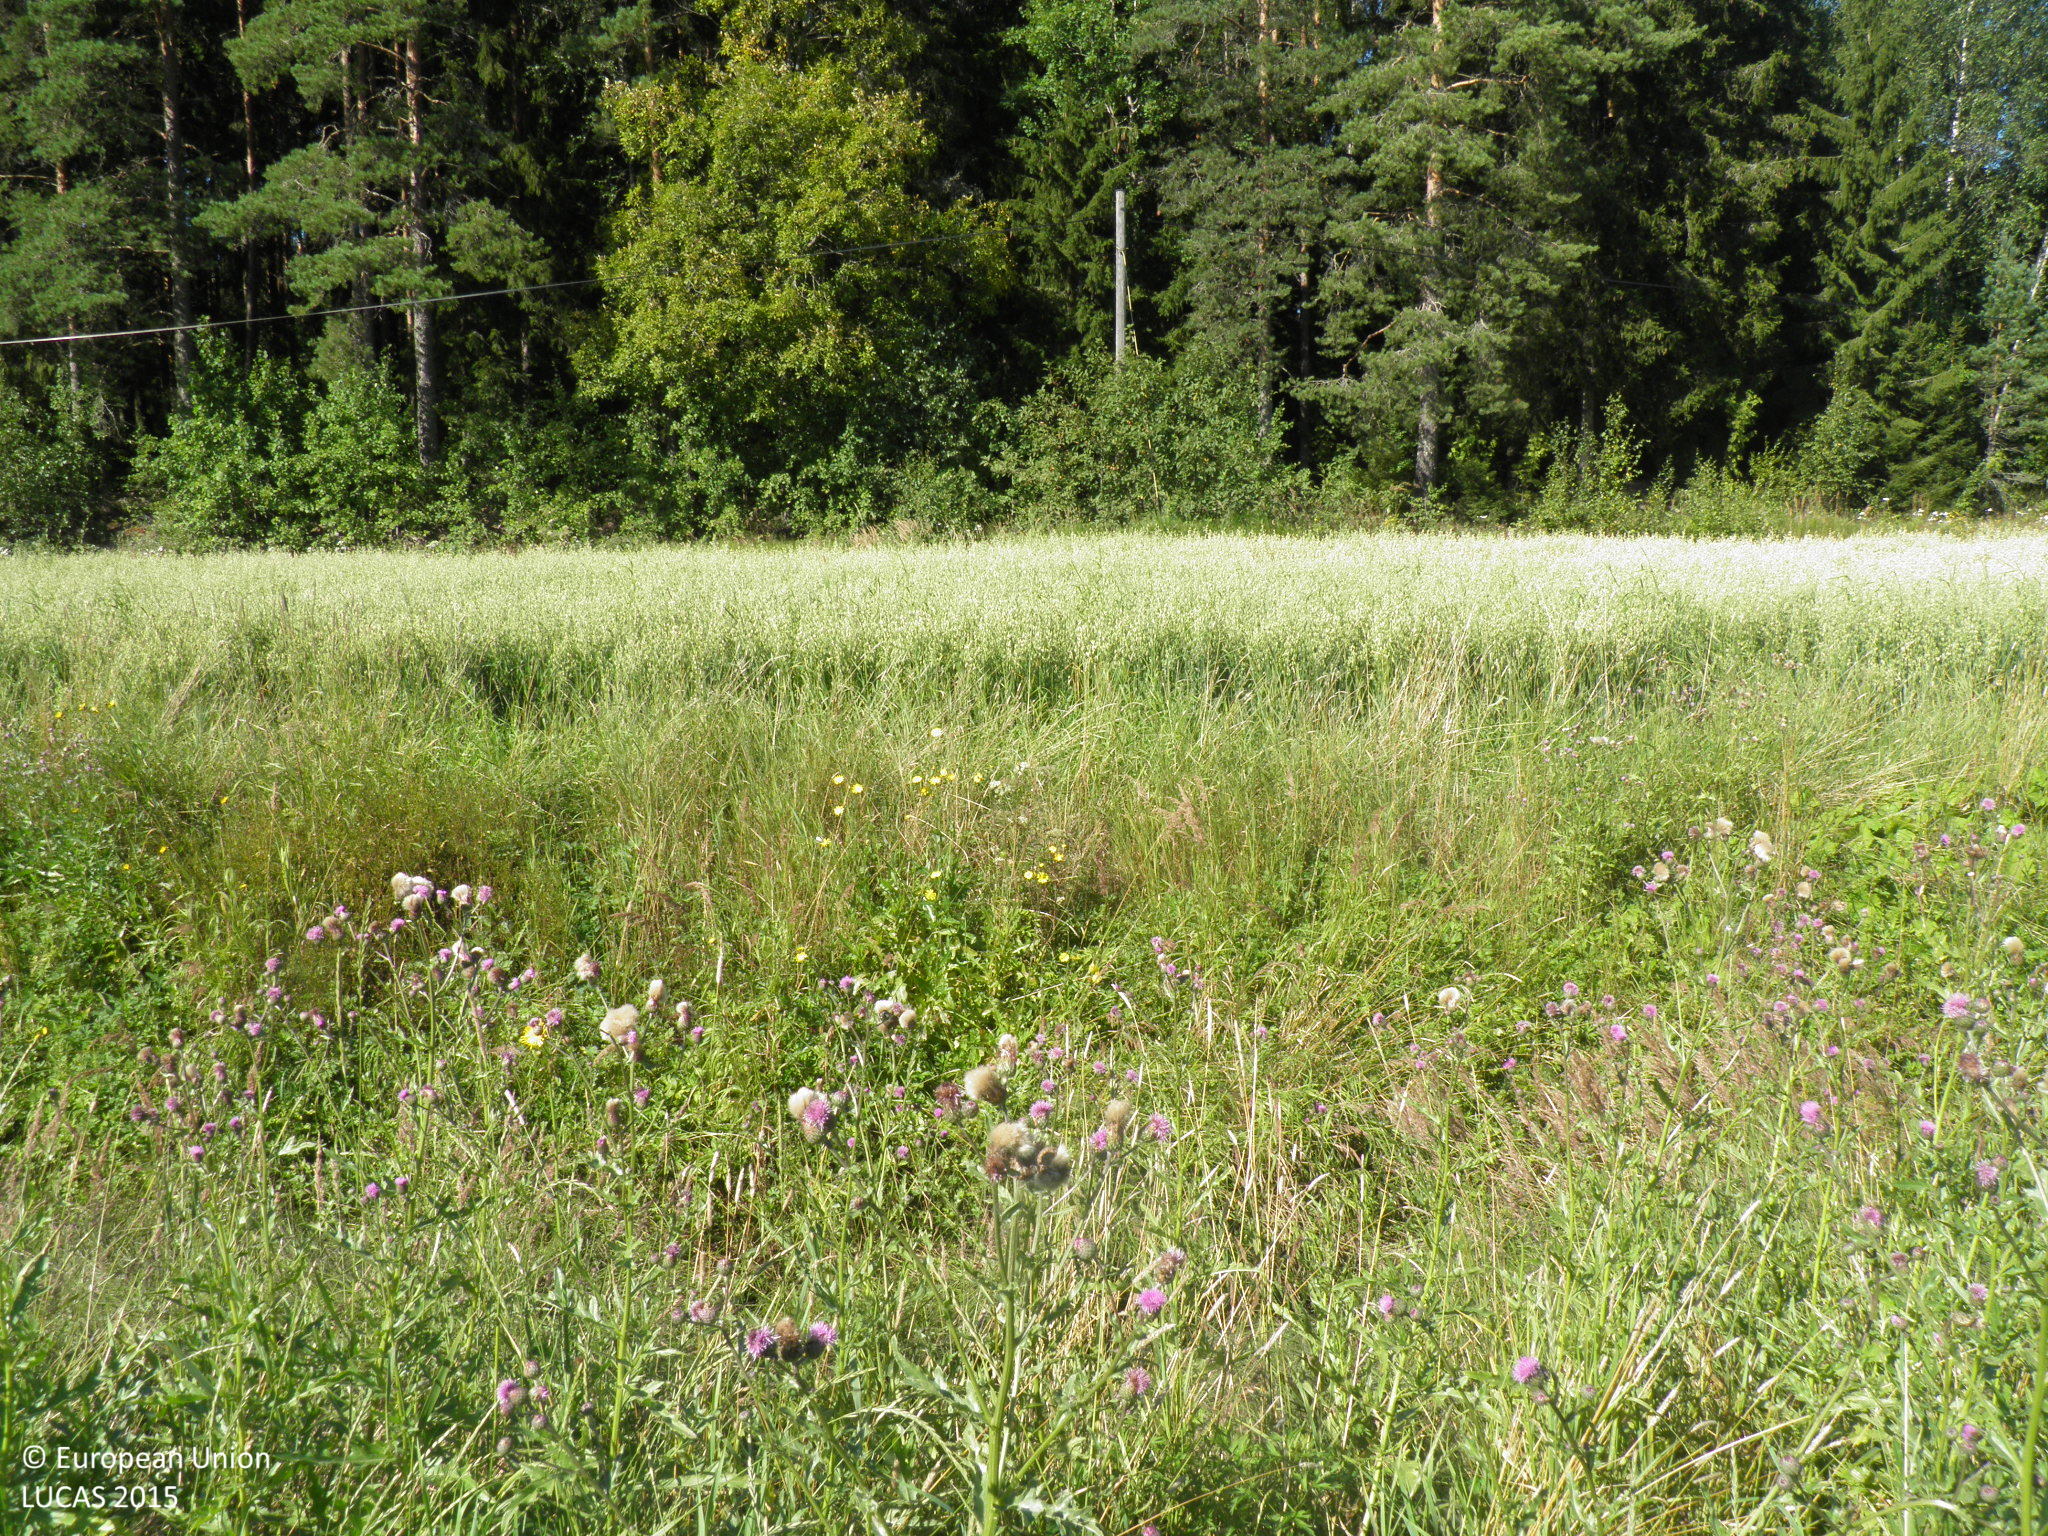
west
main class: Cropland
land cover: Barley
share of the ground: > 75 %
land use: Agriculture (excluding fallow land and kitchen gardens)
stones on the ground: < 10 %
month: August
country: FI
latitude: 60.7631
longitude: 21.9731
